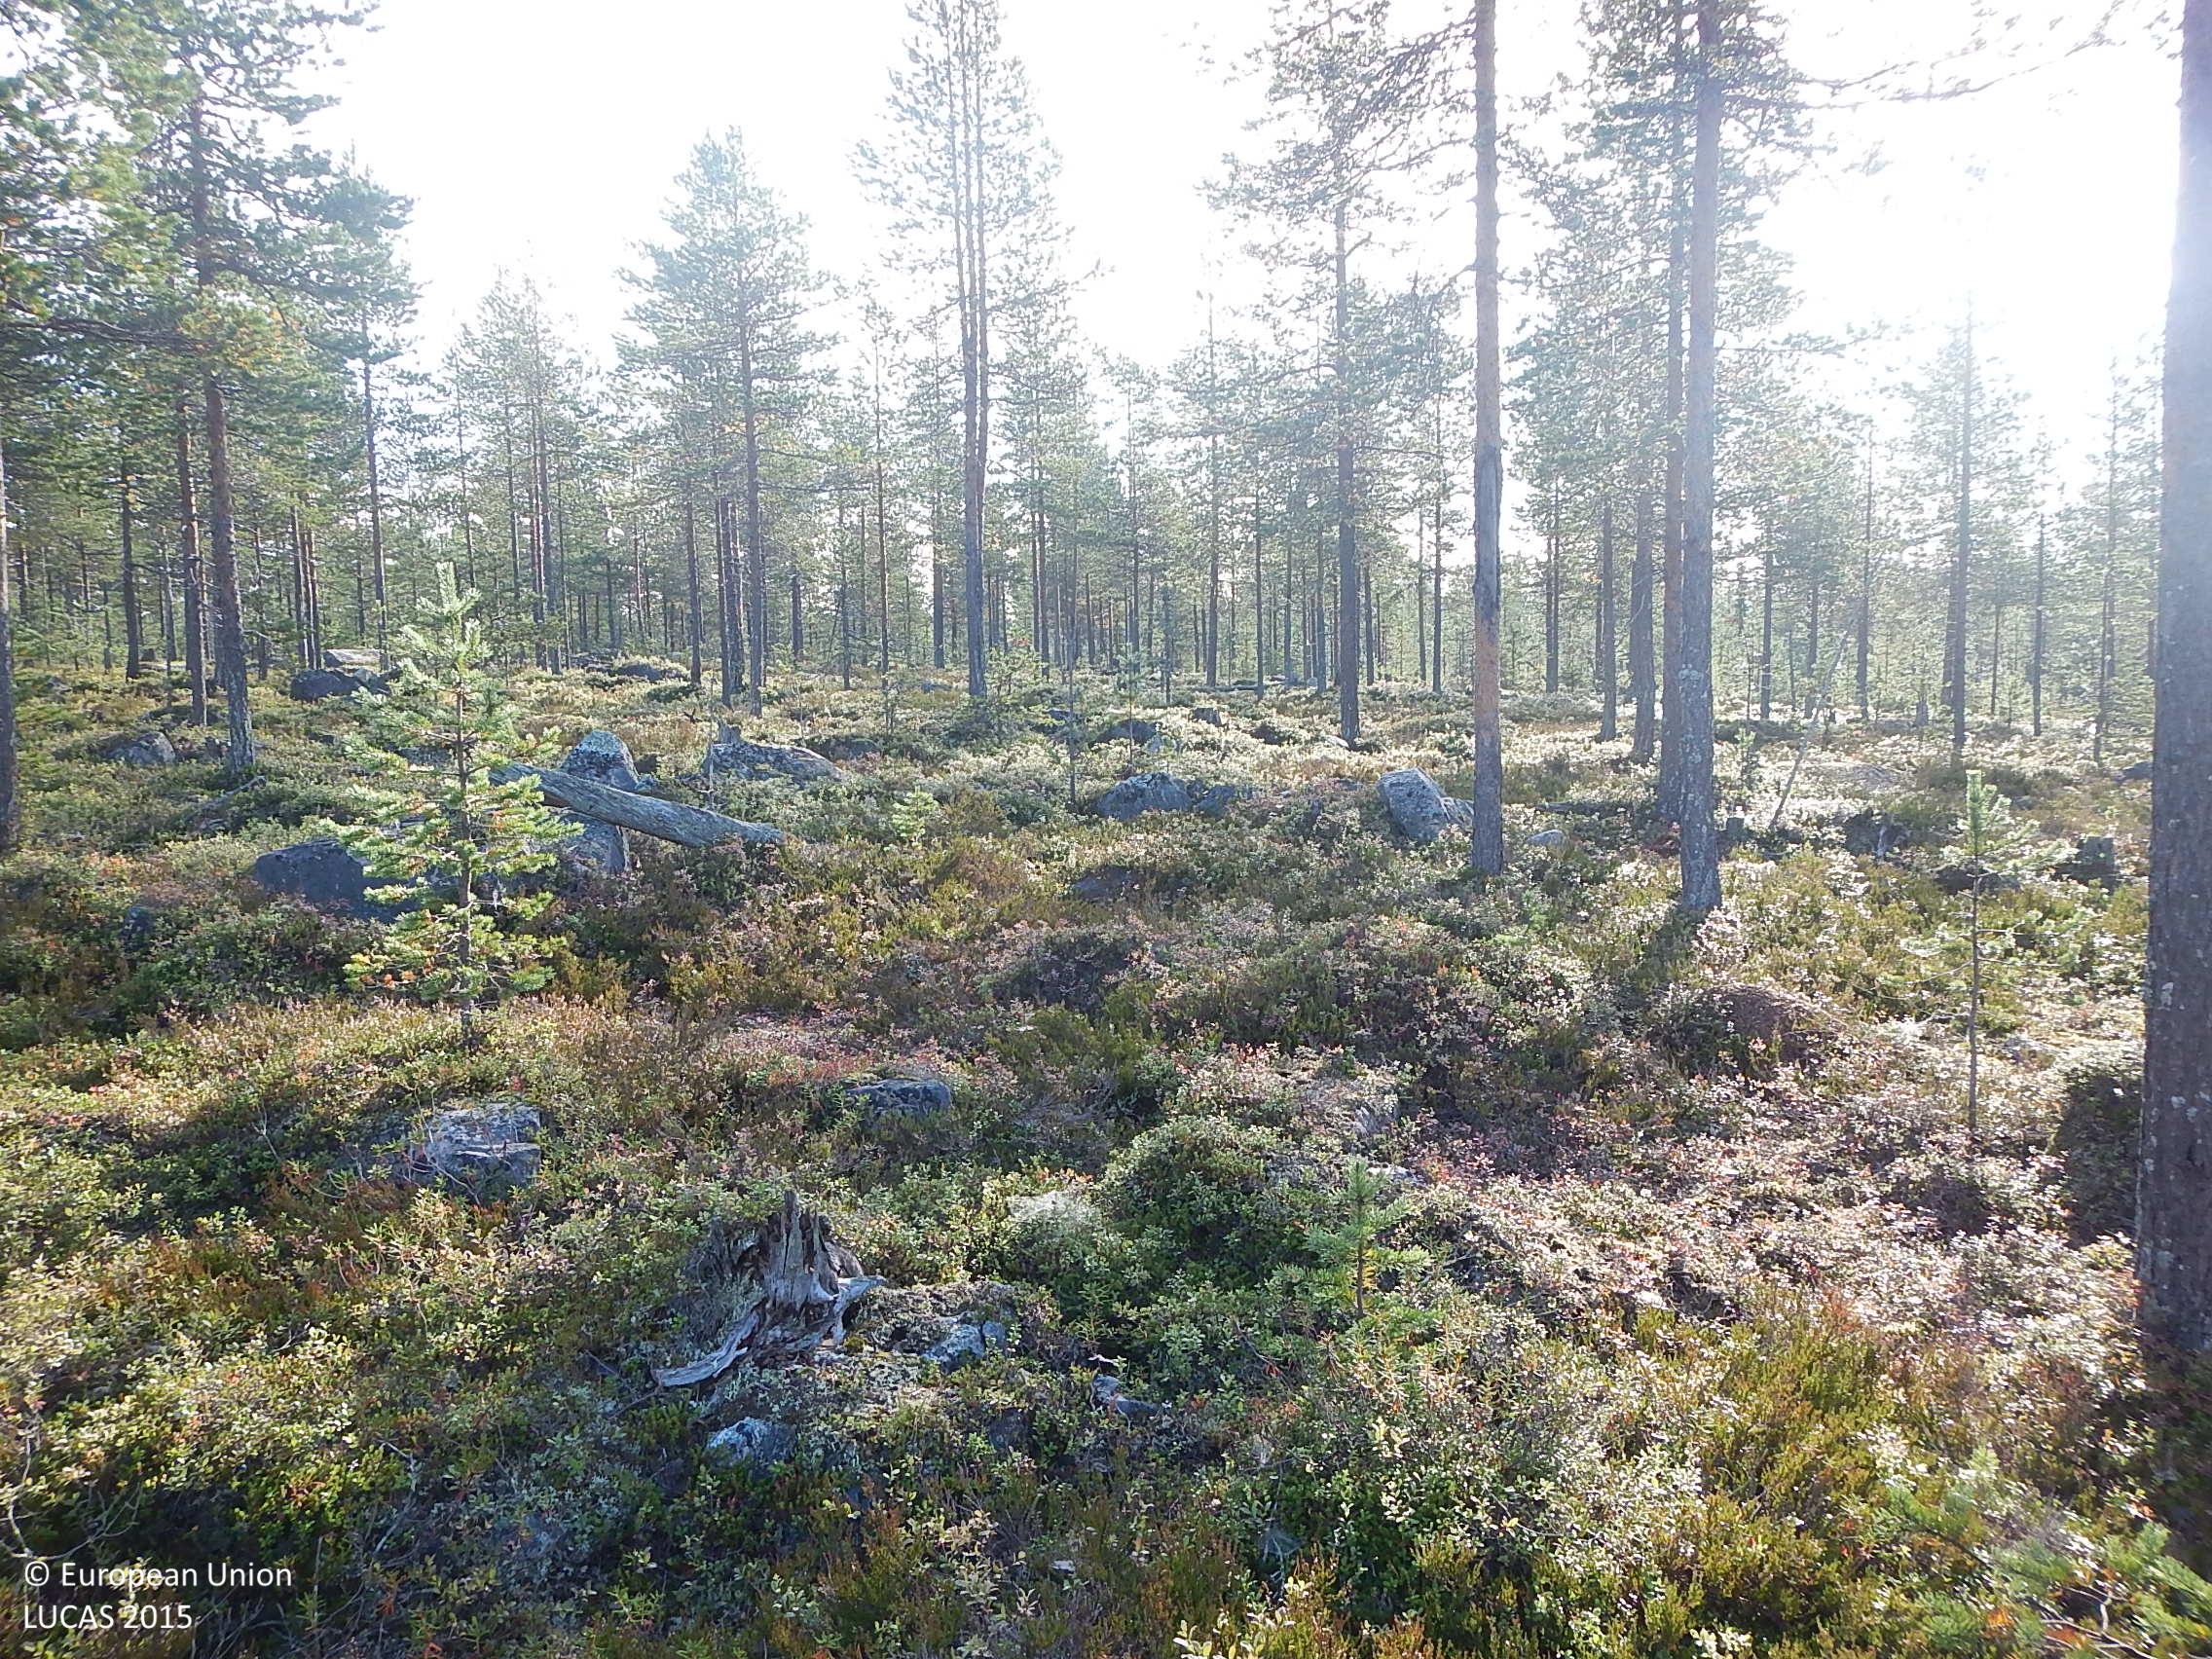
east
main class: Woodland
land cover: Pine dominated coniferous woodland
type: boreal forest
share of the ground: 10 - 25 %
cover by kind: shrubs 80 %, coniferous forest trees 20 %
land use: Forestry
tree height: < 5 m
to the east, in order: Pine dominated coniferous woodland; Tracks; Pine dominated coniferous woodland
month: August
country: FI
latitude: 65.4626
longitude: 26.9687
